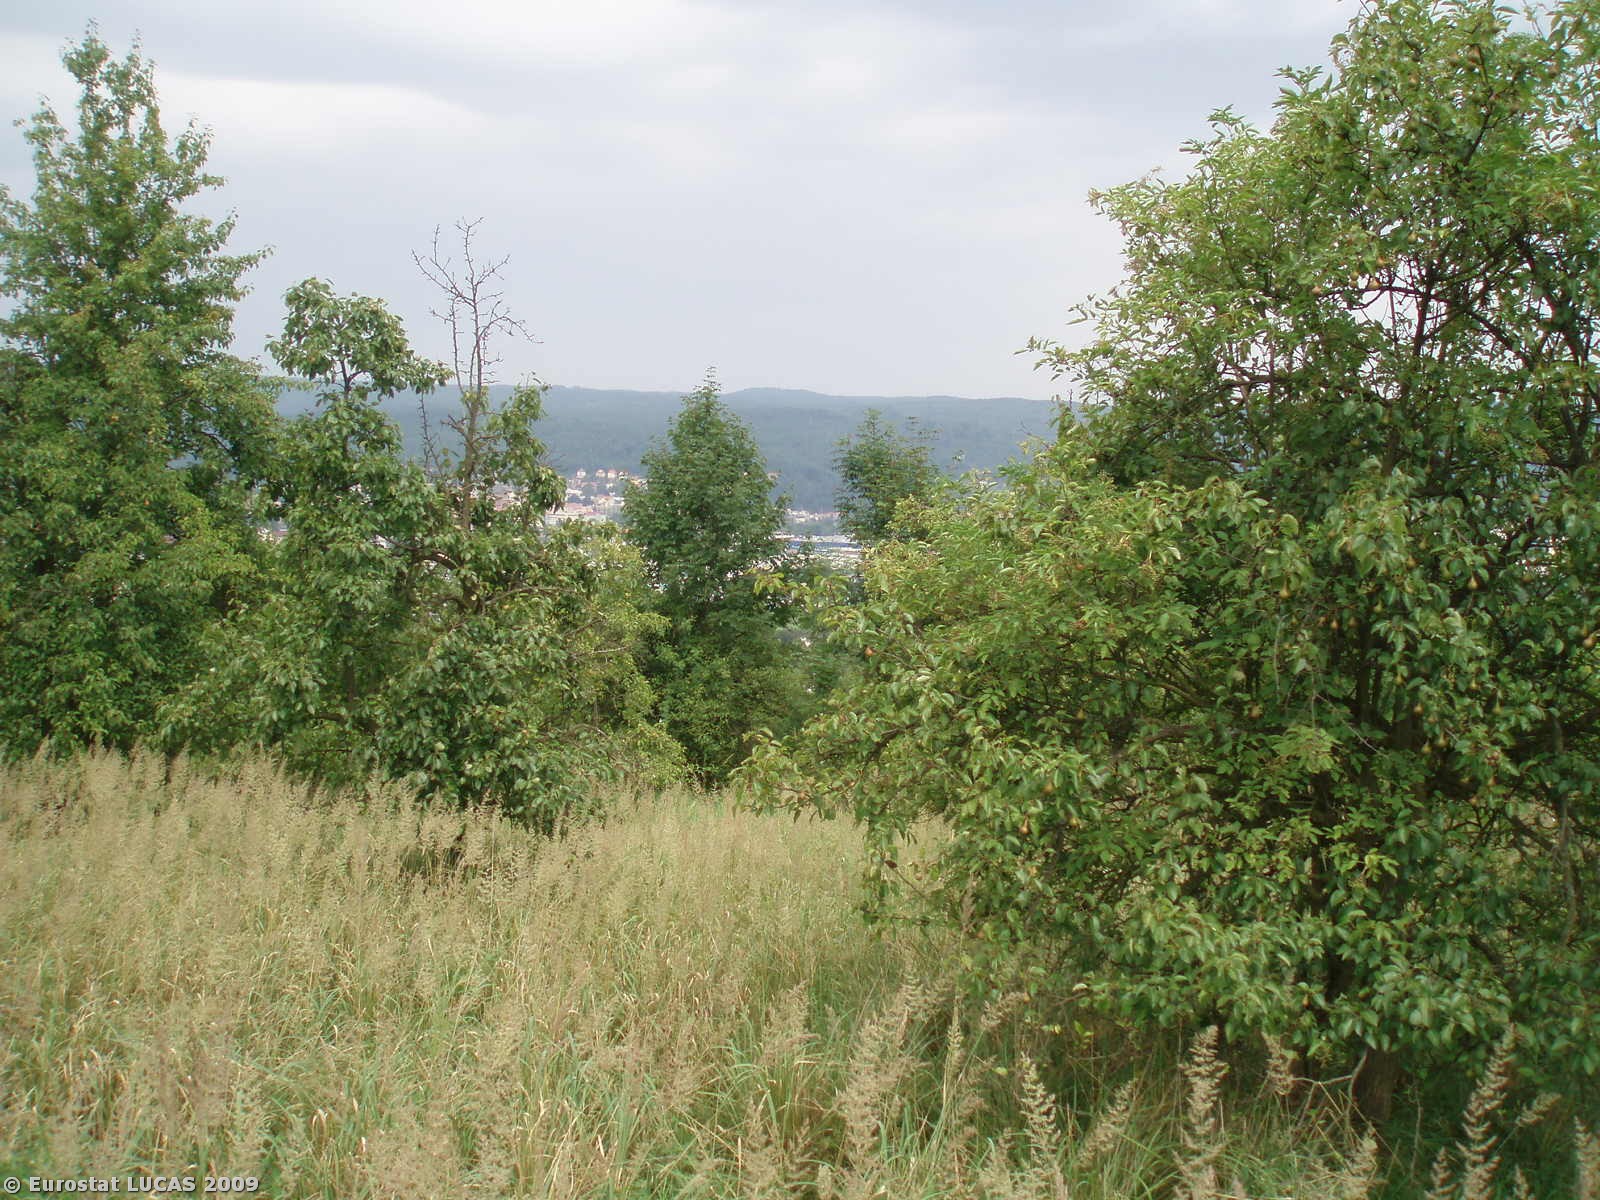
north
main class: Cropland
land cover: Pear fruit
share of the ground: 50 - 75 %
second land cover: Grassland with sparse tree/shrub cover
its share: > 75 %
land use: Agriculture (excluding fallow land and kitchen gardens)
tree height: > 5 m
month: July
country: CZ
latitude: 50.7547
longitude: 14.2113
